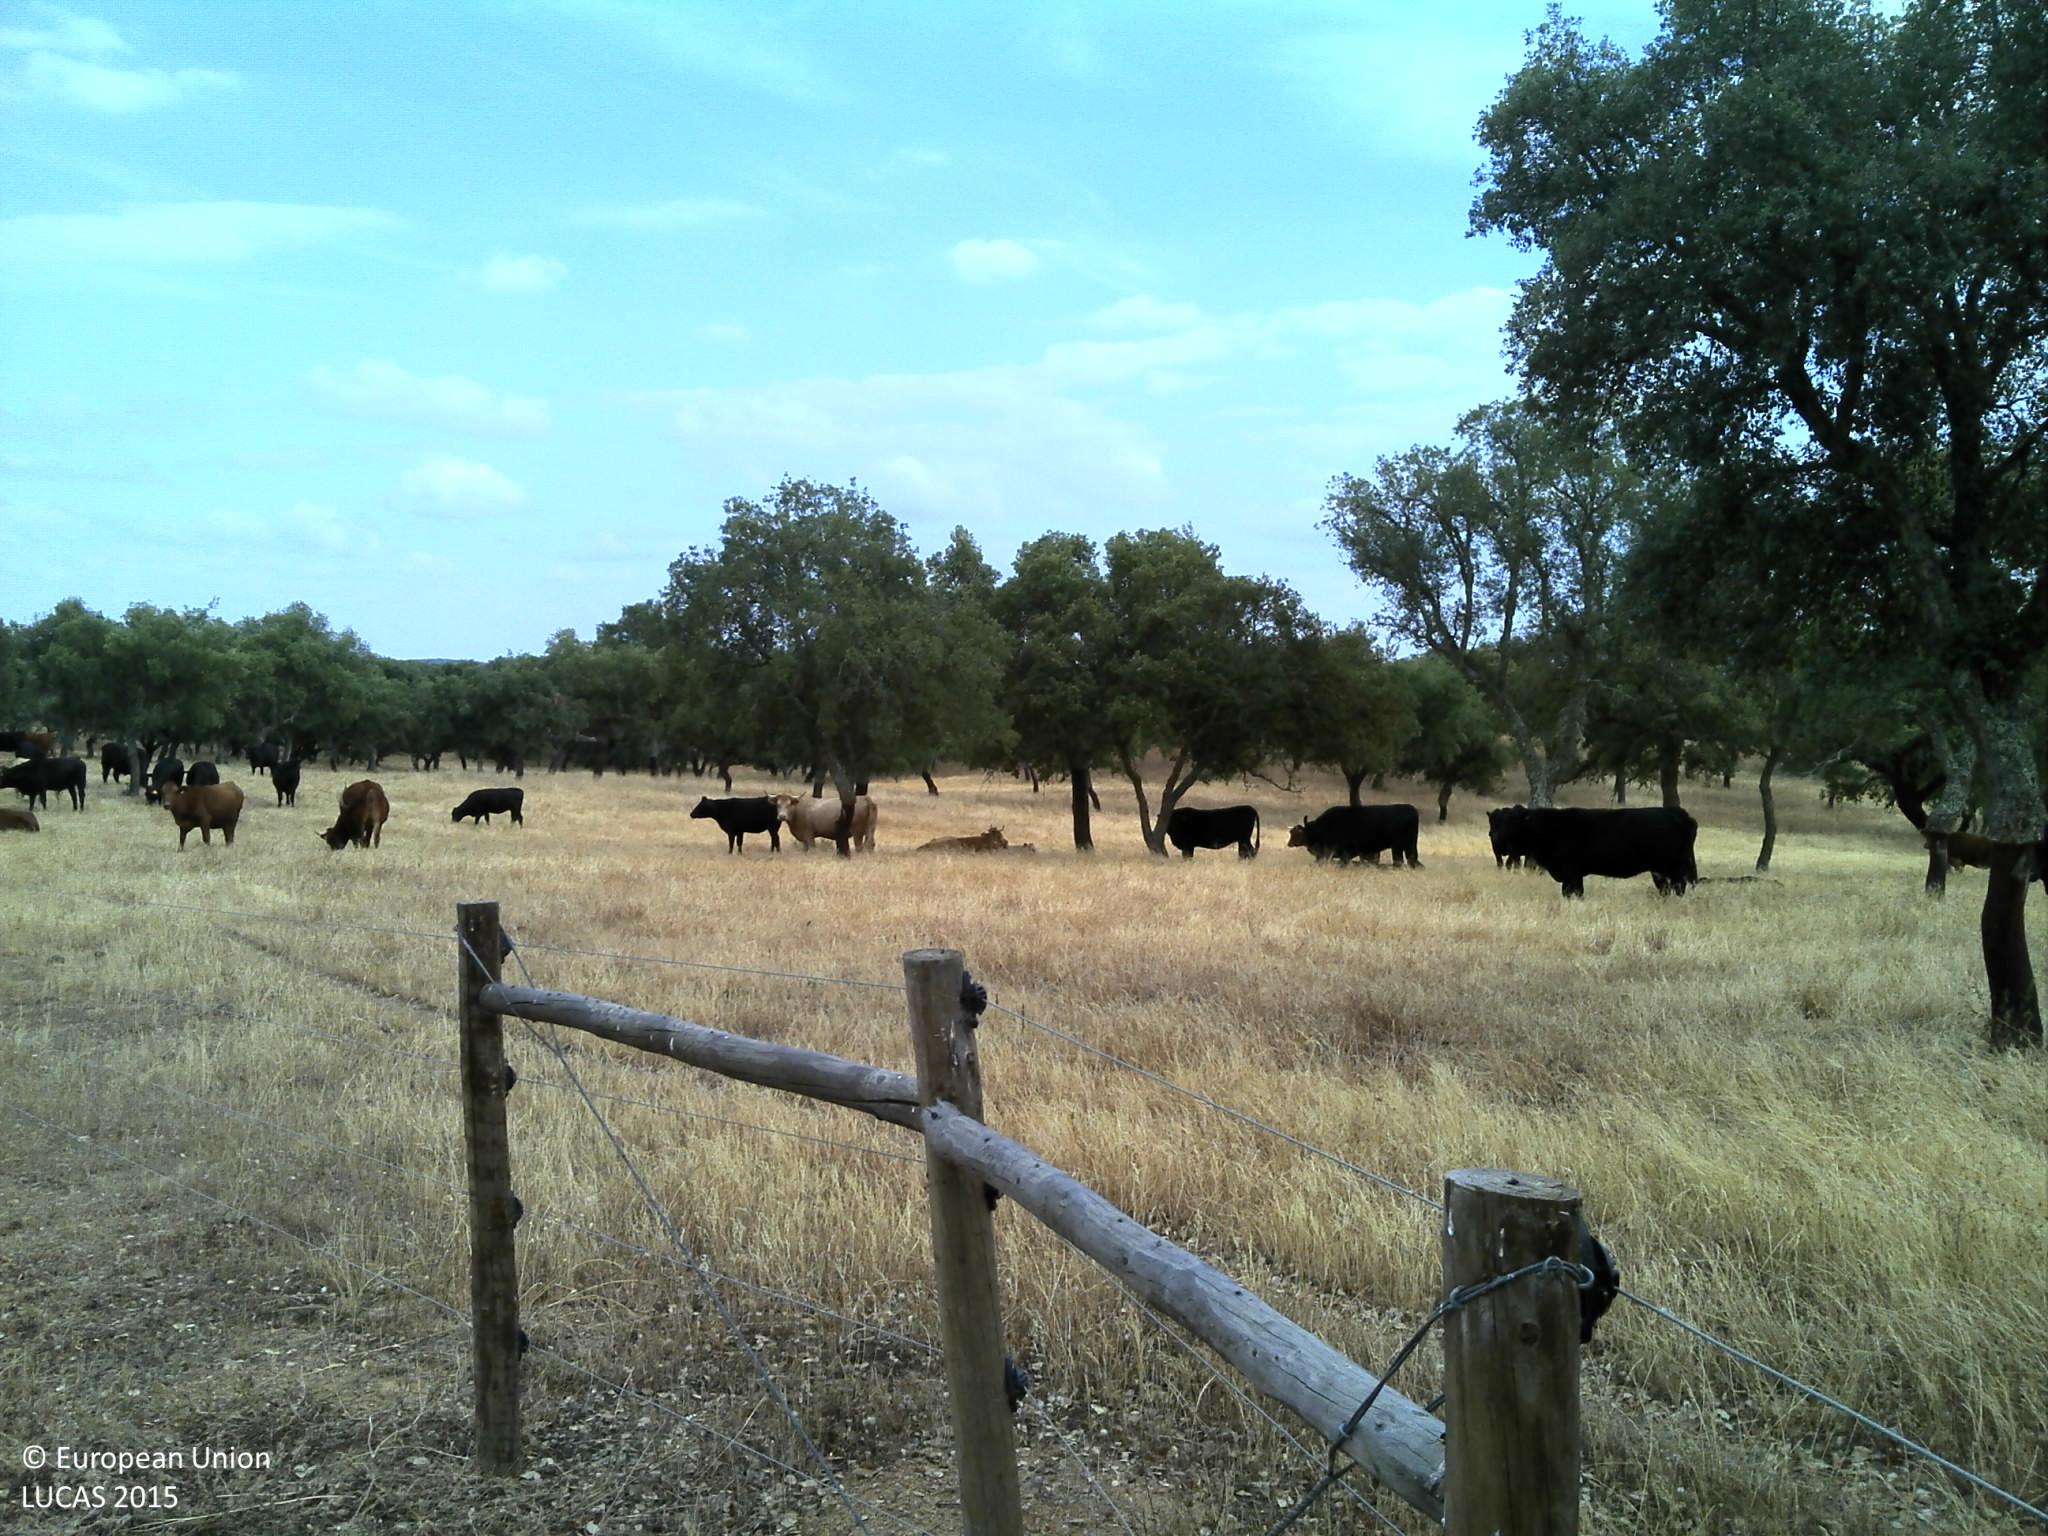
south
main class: Woodland
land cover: Broadleaved woodland
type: broadleaved evergreen forest
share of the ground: 25 - 50 %
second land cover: Spontaneously vegetated surfaces
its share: 50 - 75 %
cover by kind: herbaceous plants 60 %, broadleaved forest trees 25 %, unconsolidated bare surface 15 %
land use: Forestry
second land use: Agriculture (excluding fallow land and kitchen gardens)
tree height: > 5 m
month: June
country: PT
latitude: 38.3998
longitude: -7.8167
